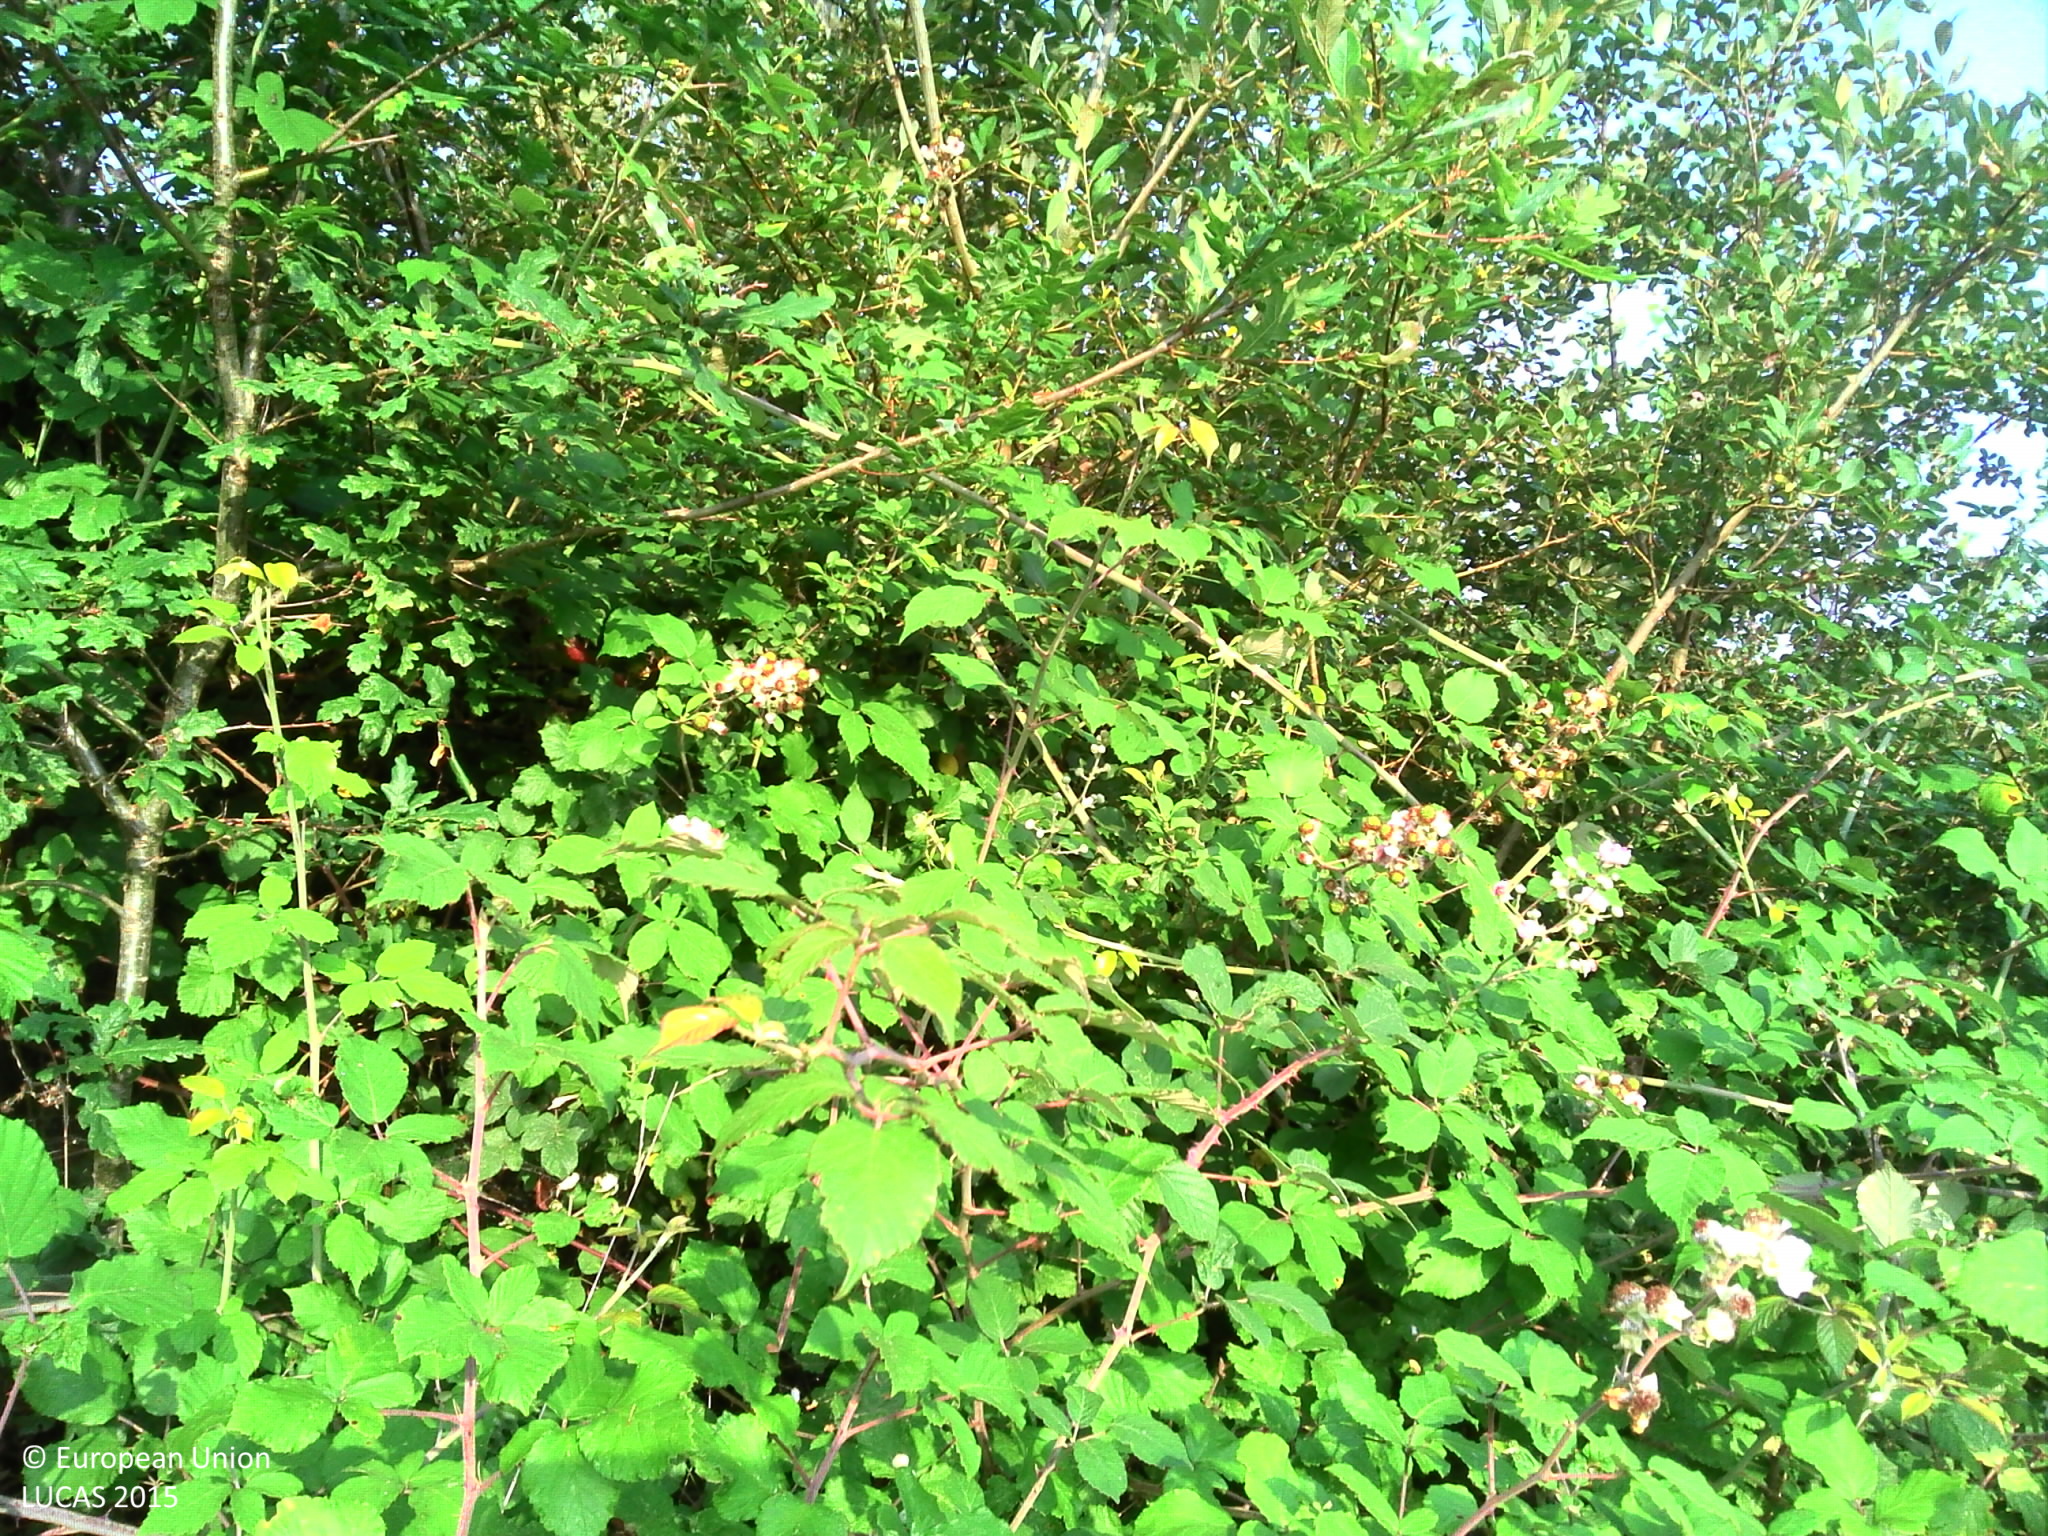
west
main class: Grassland
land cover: Spontaneously vegetated surfaces
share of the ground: > 75 %
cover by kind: herbaceous plants 100 %
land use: Semi-natural and natural areas not in use
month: July
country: FR
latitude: 43.1343
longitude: 1.1155
